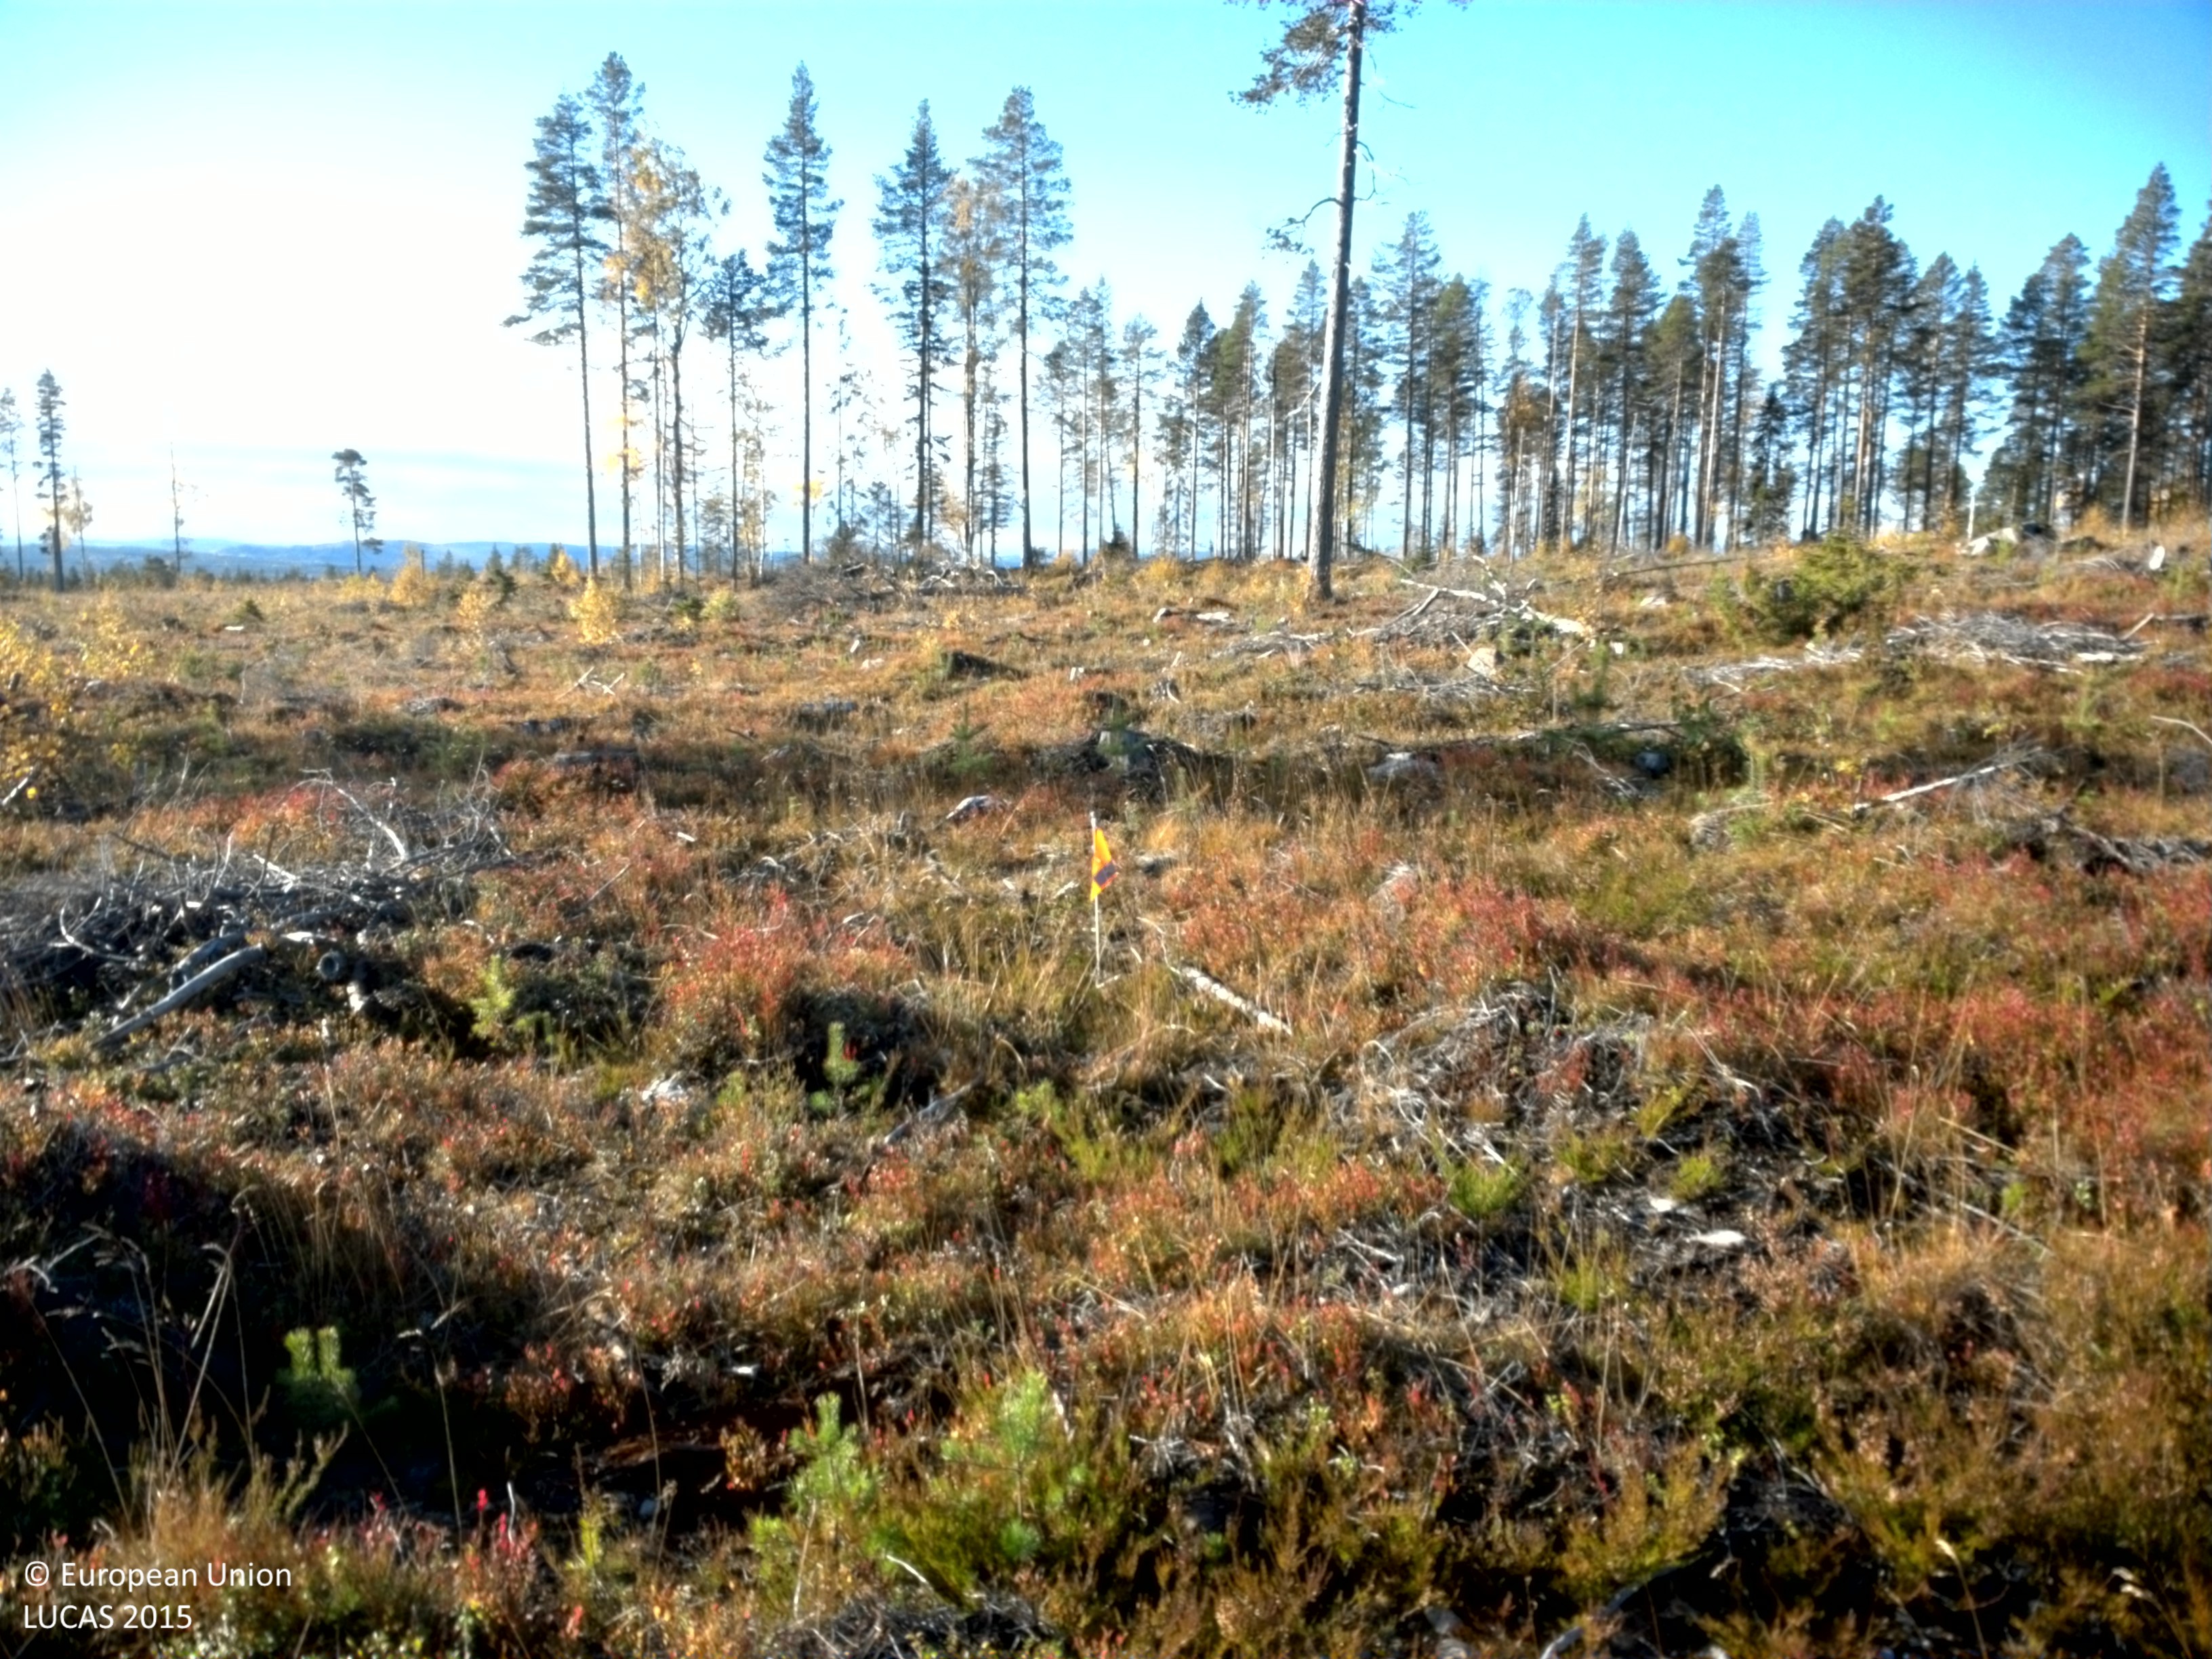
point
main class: Shrubland
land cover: Shrubland without tree cover
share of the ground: 50 - 75 %
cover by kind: shrubs 60 %, herbaceous plants 20 %, unconsolidated bare surface 10 %, lichens and mosses 5 %
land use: Forestry
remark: Clear cut
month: September
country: SE
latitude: 65.0198
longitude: 17.8794
